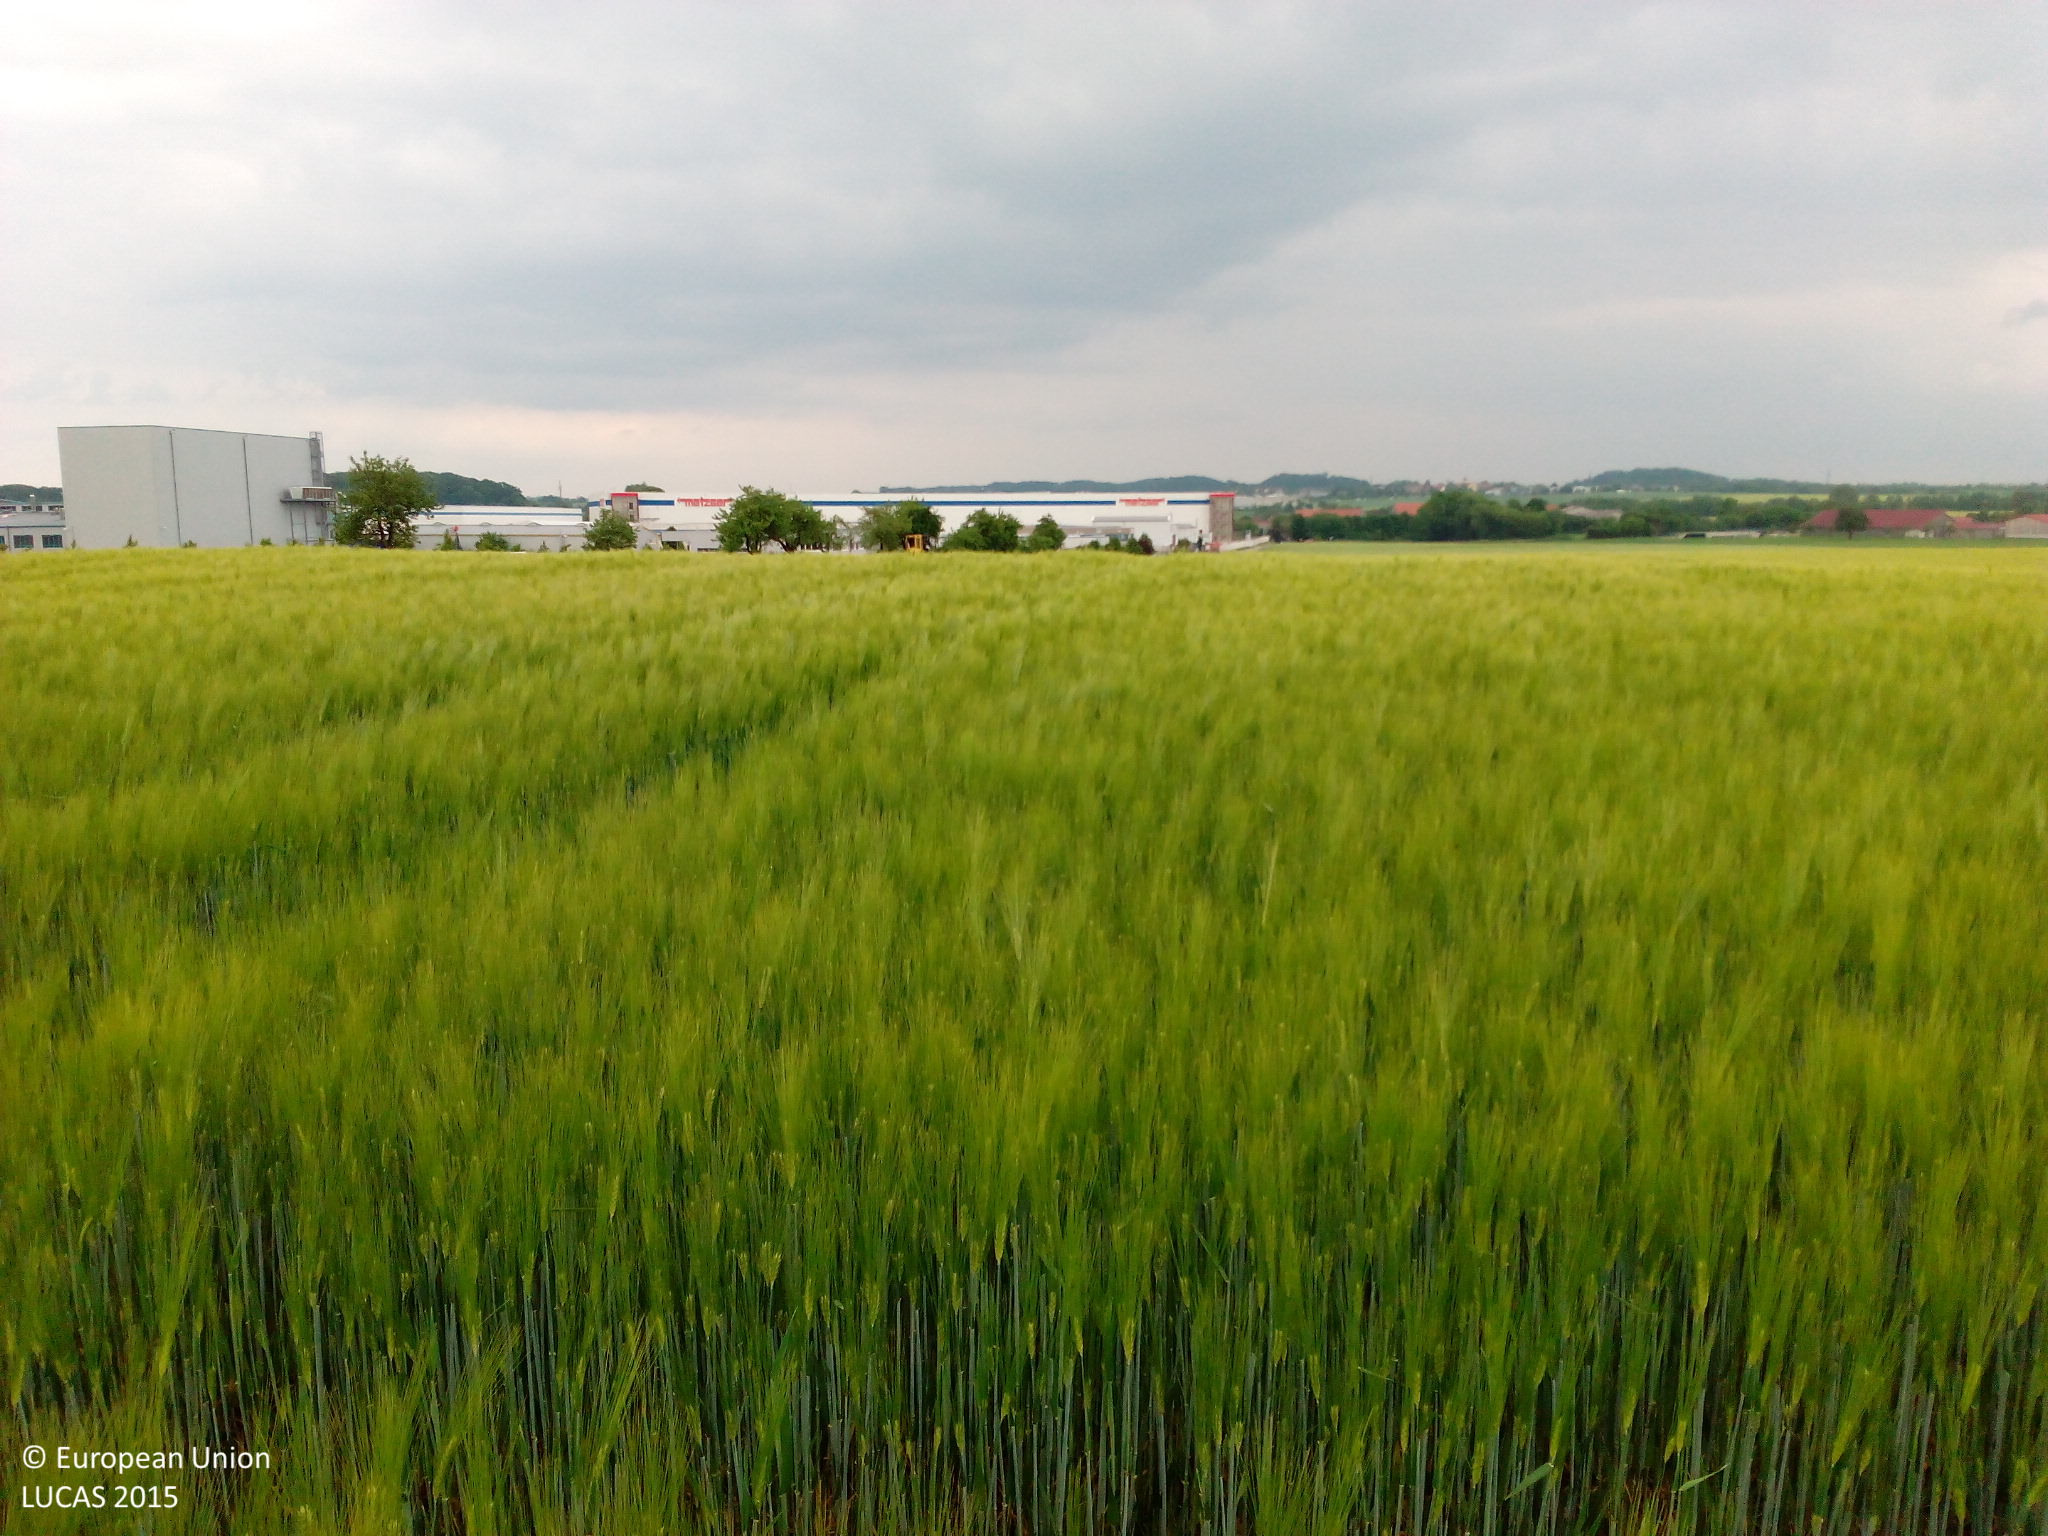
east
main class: Cropland
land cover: Barley
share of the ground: > 75 %
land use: Agriculture (excluding fallow land and kitchen gardens)
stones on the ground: < 10 %
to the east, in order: Barley; Spontaneously vegetated surfaces; Tracks; Grassland without tree/shrub cover
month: May
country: DE
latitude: 49.1766
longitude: 9.6846
